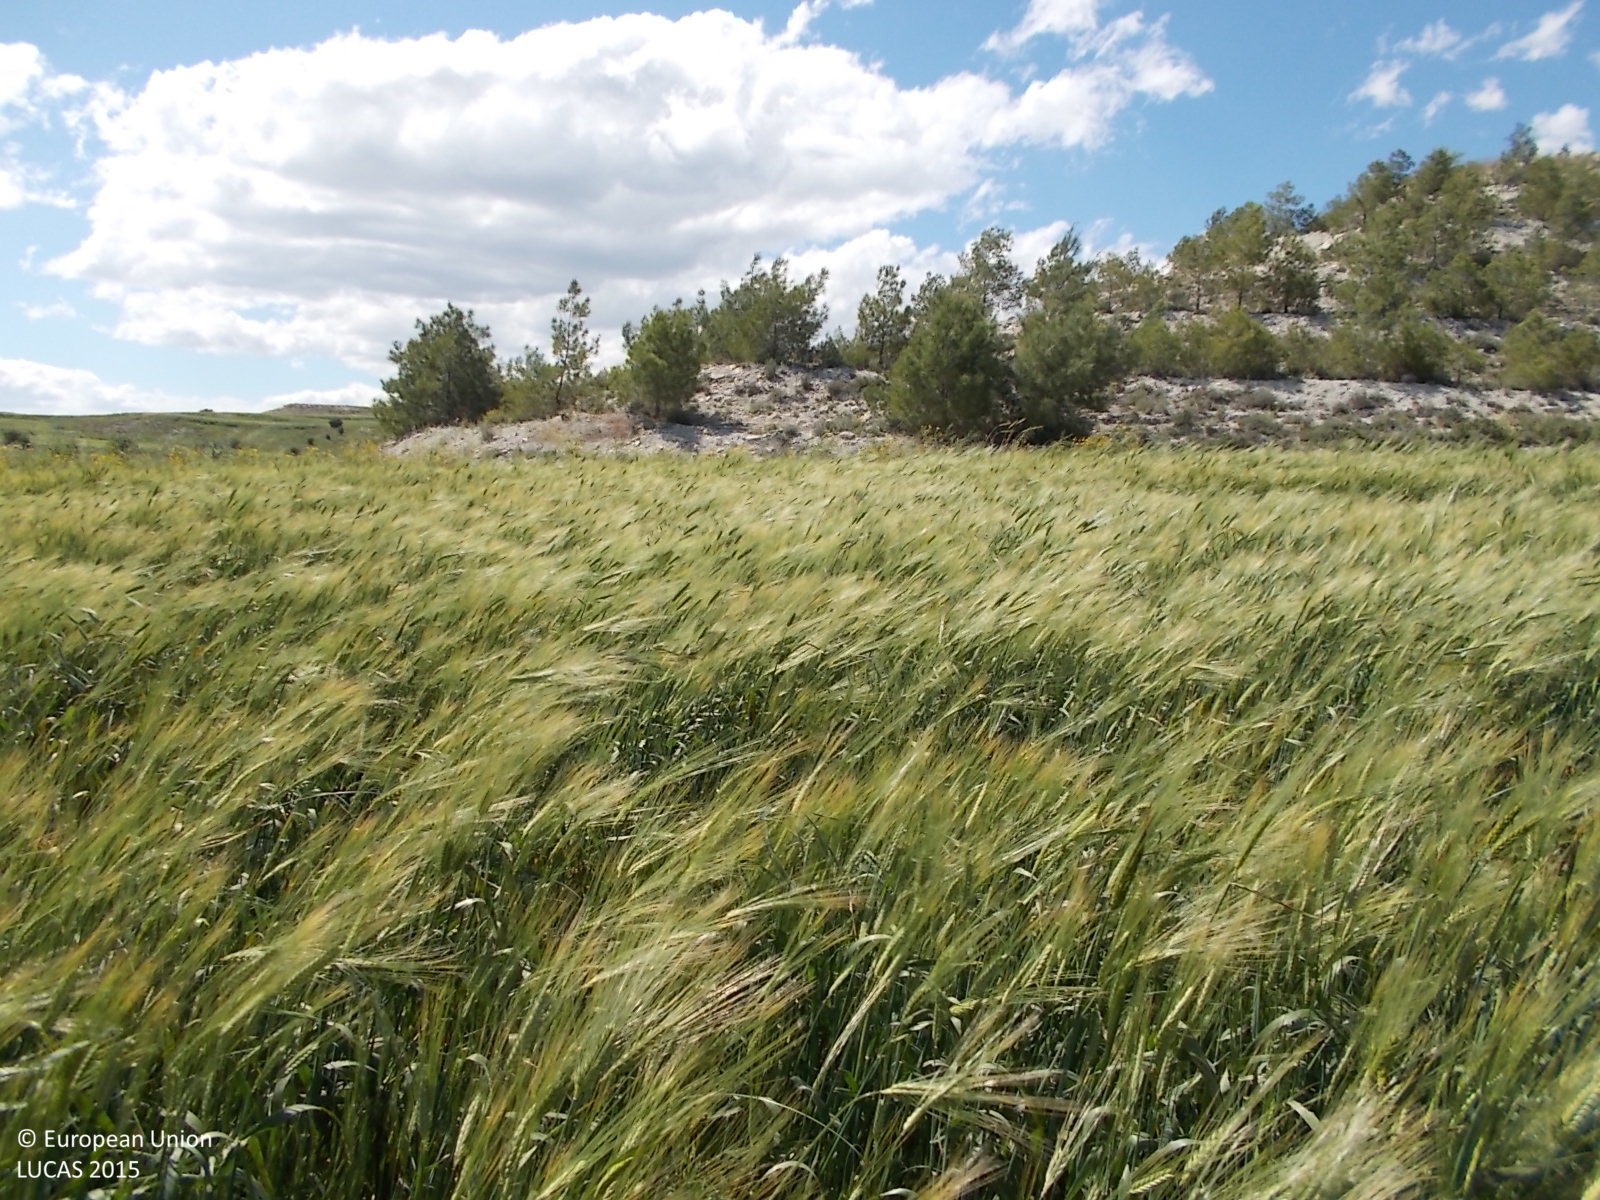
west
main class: Cropland
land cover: Barley
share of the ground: > 75 %
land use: Agriculture (excluding fallow land and kitchen gardens)
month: April
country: CY
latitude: 34.9971
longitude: 33.5208
